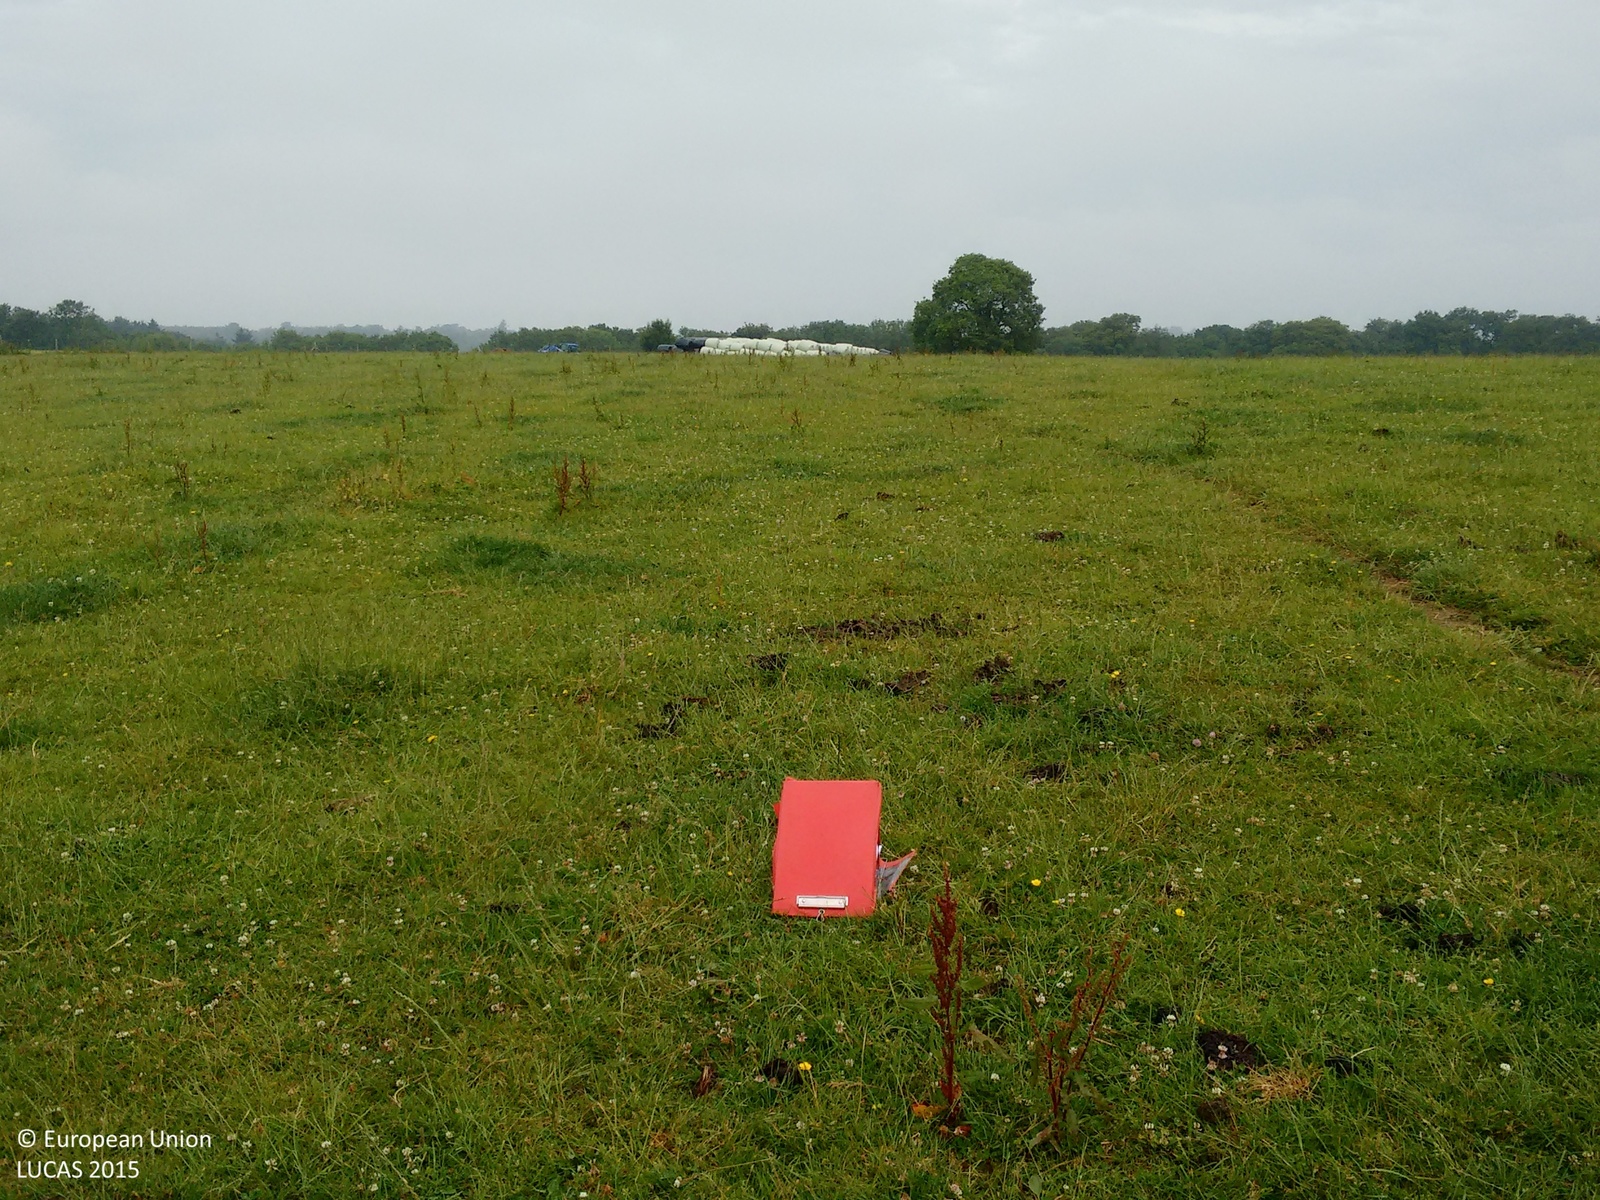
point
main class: Grassland
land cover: Grassland without tree/shrub cover
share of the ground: > 75 %
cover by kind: herbaceous plants 100 %
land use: Agriculture (excluding fallow land and kitchen gardens)
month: July
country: GB
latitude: 51.0533
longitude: -0.1491
